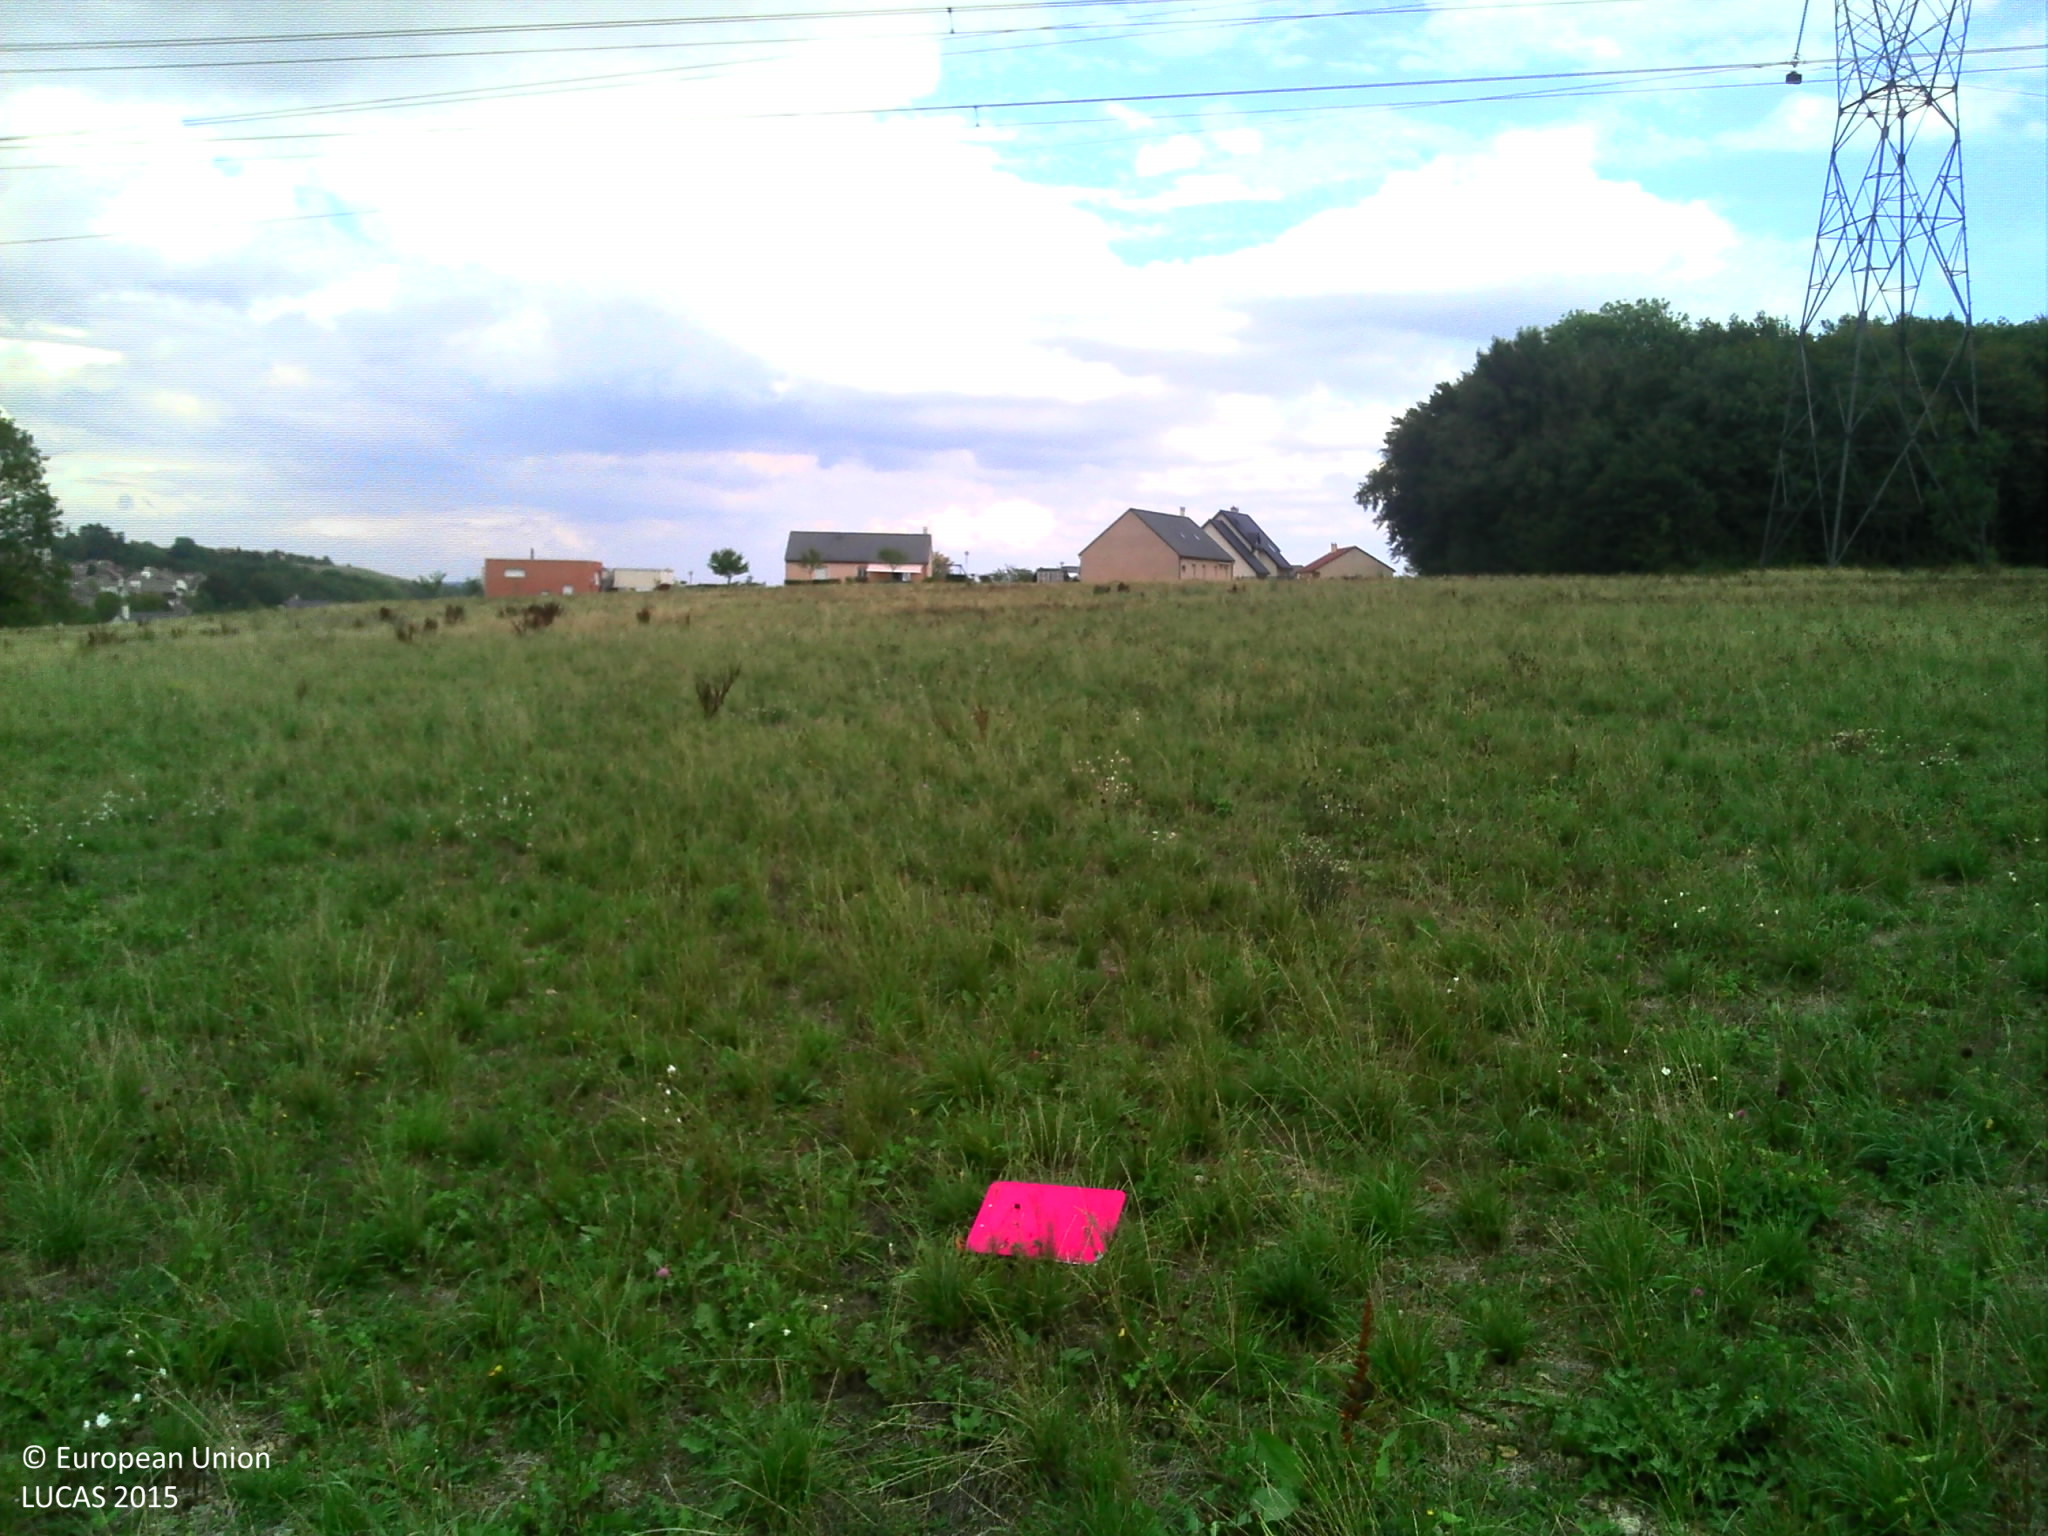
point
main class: Cropland
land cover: Temporary grasslands
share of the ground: > 75 %
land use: Agriculture (excluding fallow land and kitchen gardens)
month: August
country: FR
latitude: 47.3023
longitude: 4.6964
